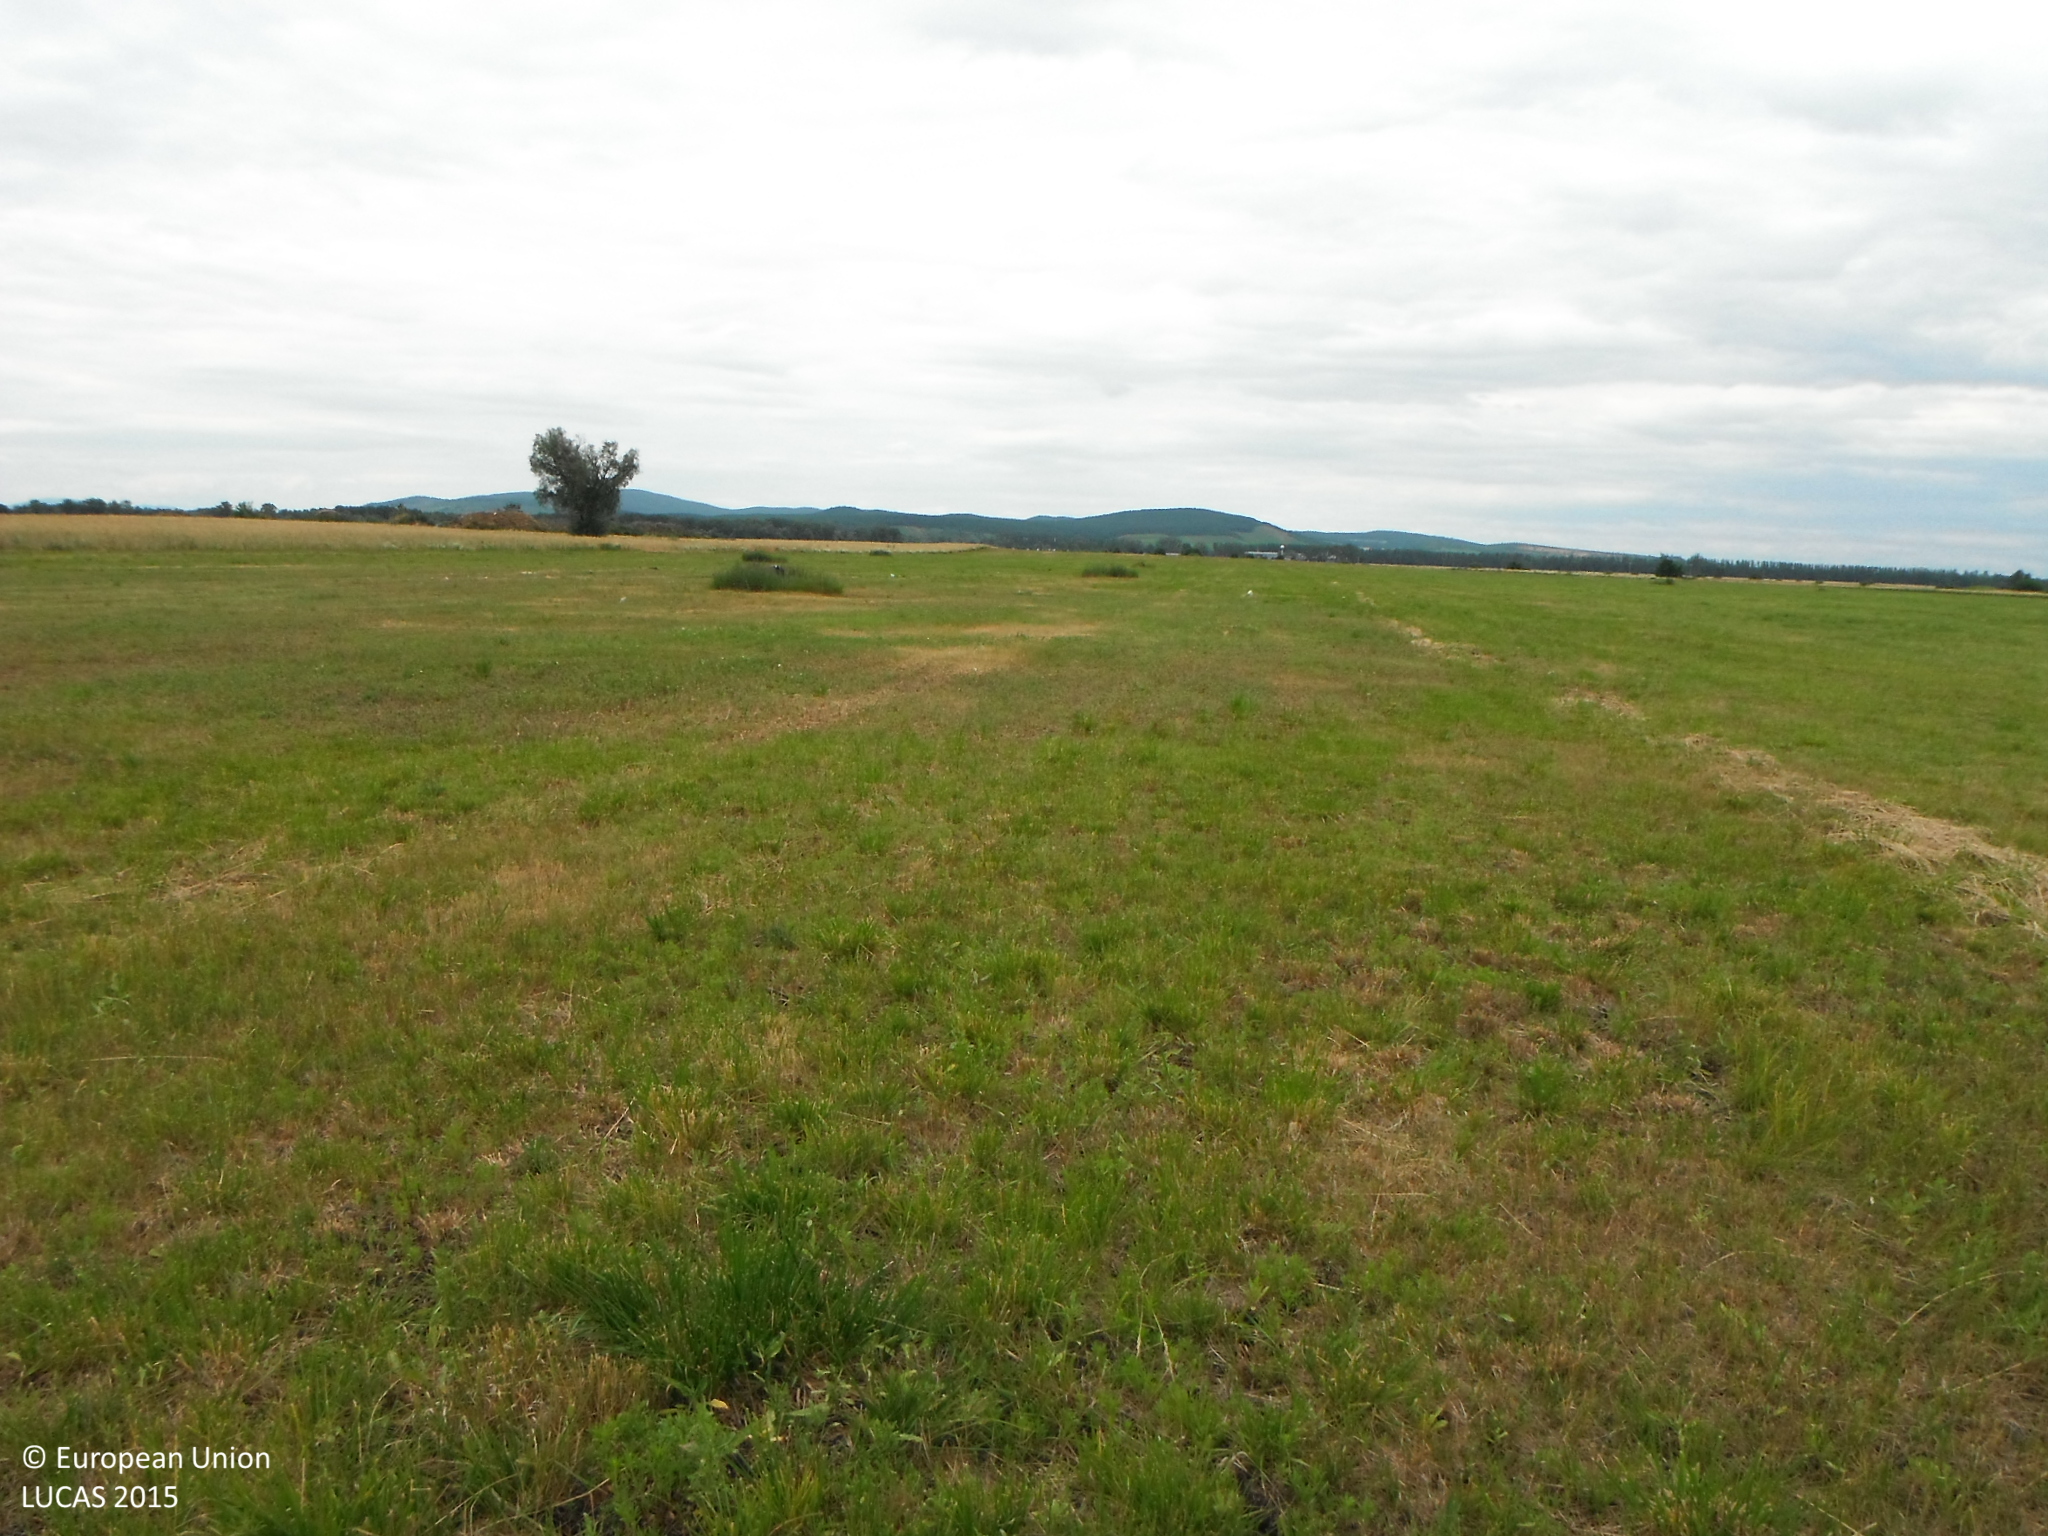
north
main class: Grassland
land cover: Grassland without tree/shrub cover
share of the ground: > 75 %
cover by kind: herbaceous plants 100 %
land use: Agriculture (excluding fallow land and kitchen gardens)
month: June
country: SK
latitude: 48.3591
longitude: 21.7239
